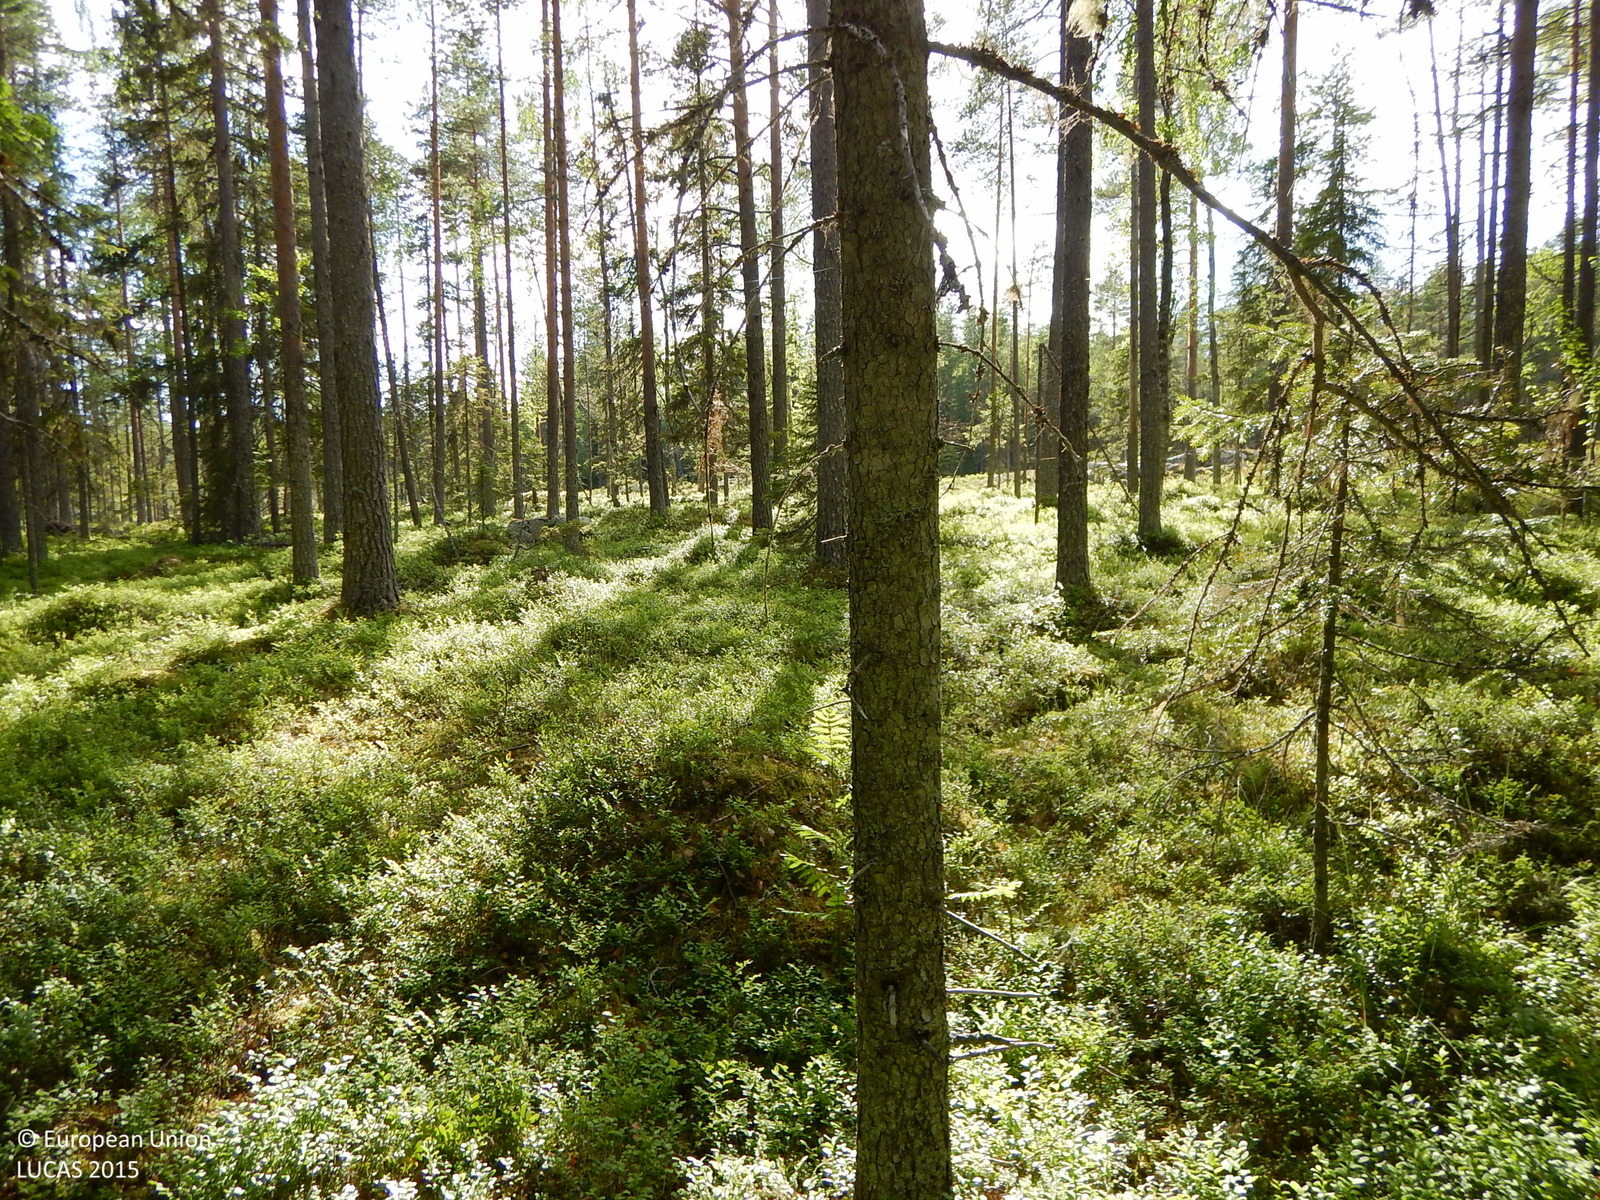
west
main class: Woodland
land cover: Spruce dominated coniferous woodland
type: boreal forest
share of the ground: 50 - 75 %
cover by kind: coniferous forest trees 65 %, shrubs 15 %, lichens and mosses 10 %, broadleaved forest trees 5 %, herbaceous plants 5 %
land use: Forestry
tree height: > 5 m
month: July
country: SE
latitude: 64.8249
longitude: 20.3601
